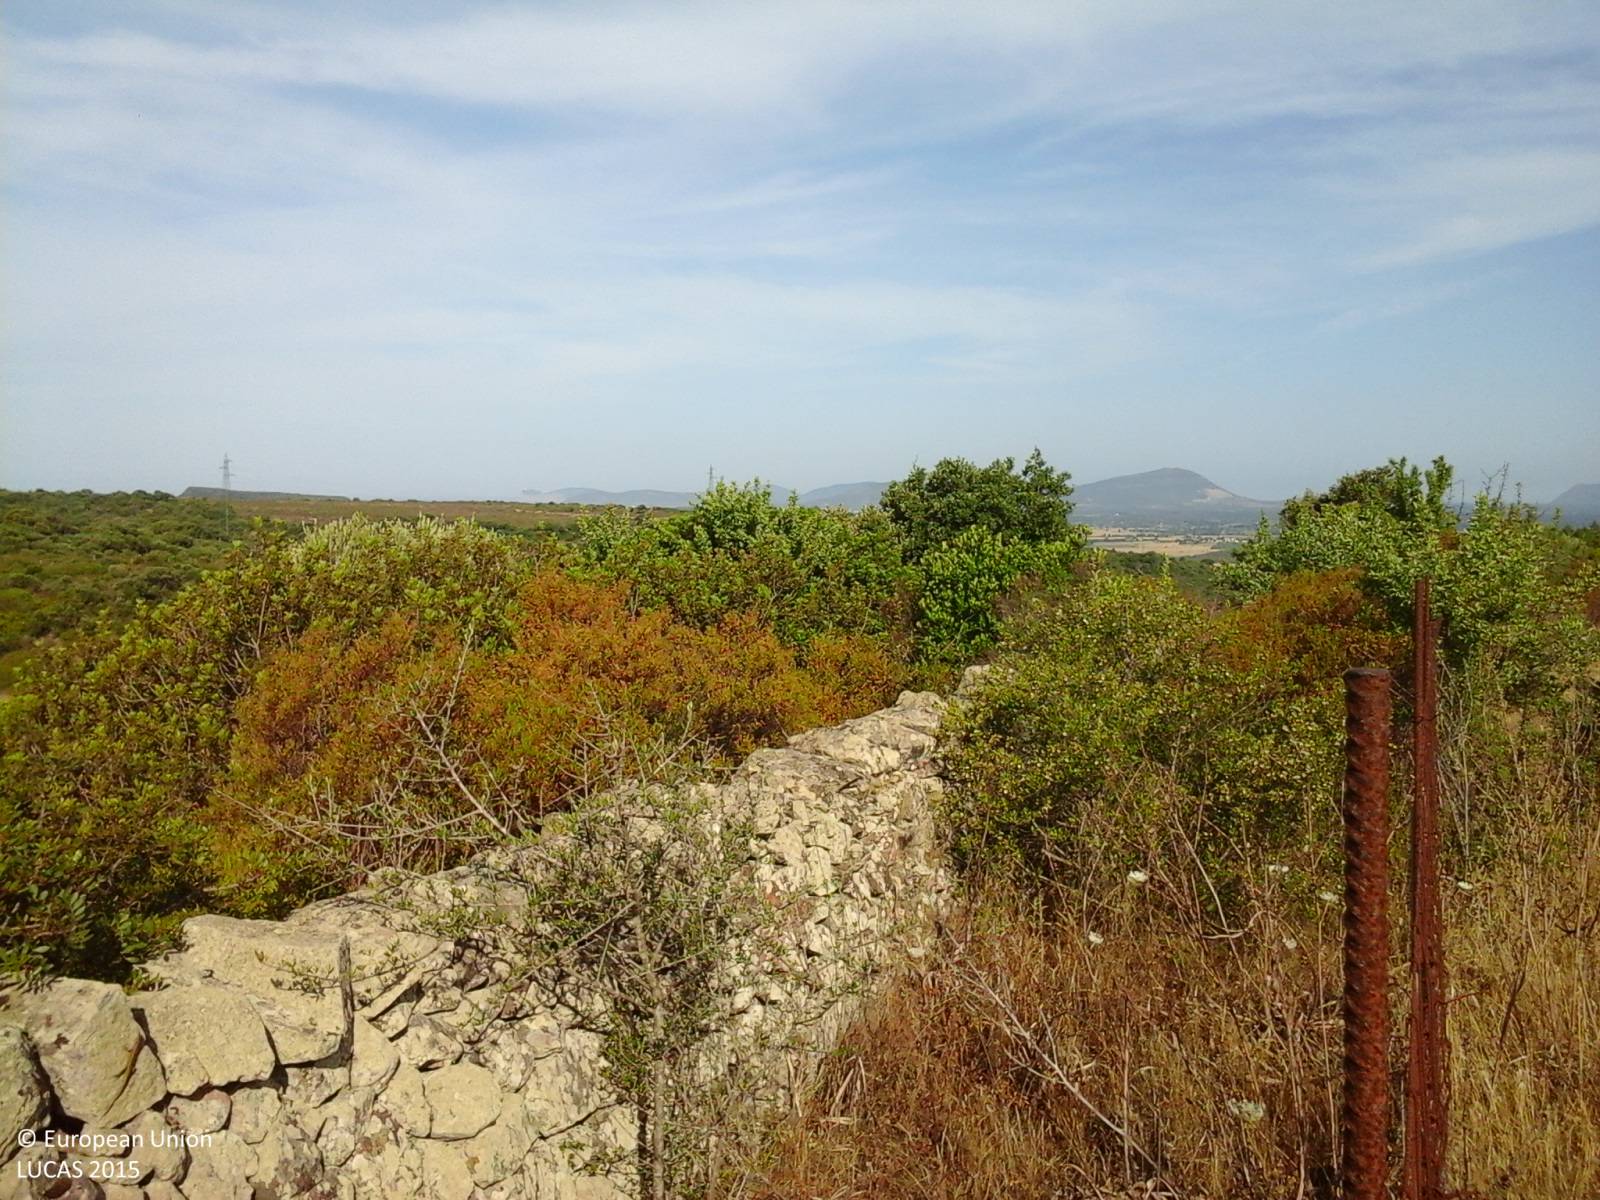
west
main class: Shrubland
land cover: Shrubland with sparse tree cover
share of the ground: > 75 %
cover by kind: herbaceous plants 75 %, shrubs 10 %, broadleaved forest trees 5 %, consolidated bare surface 5 %
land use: Semi-natural and natural areas not in use
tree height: > 5 m
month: June
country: IT
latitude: 40.5807
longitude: 8.4364
